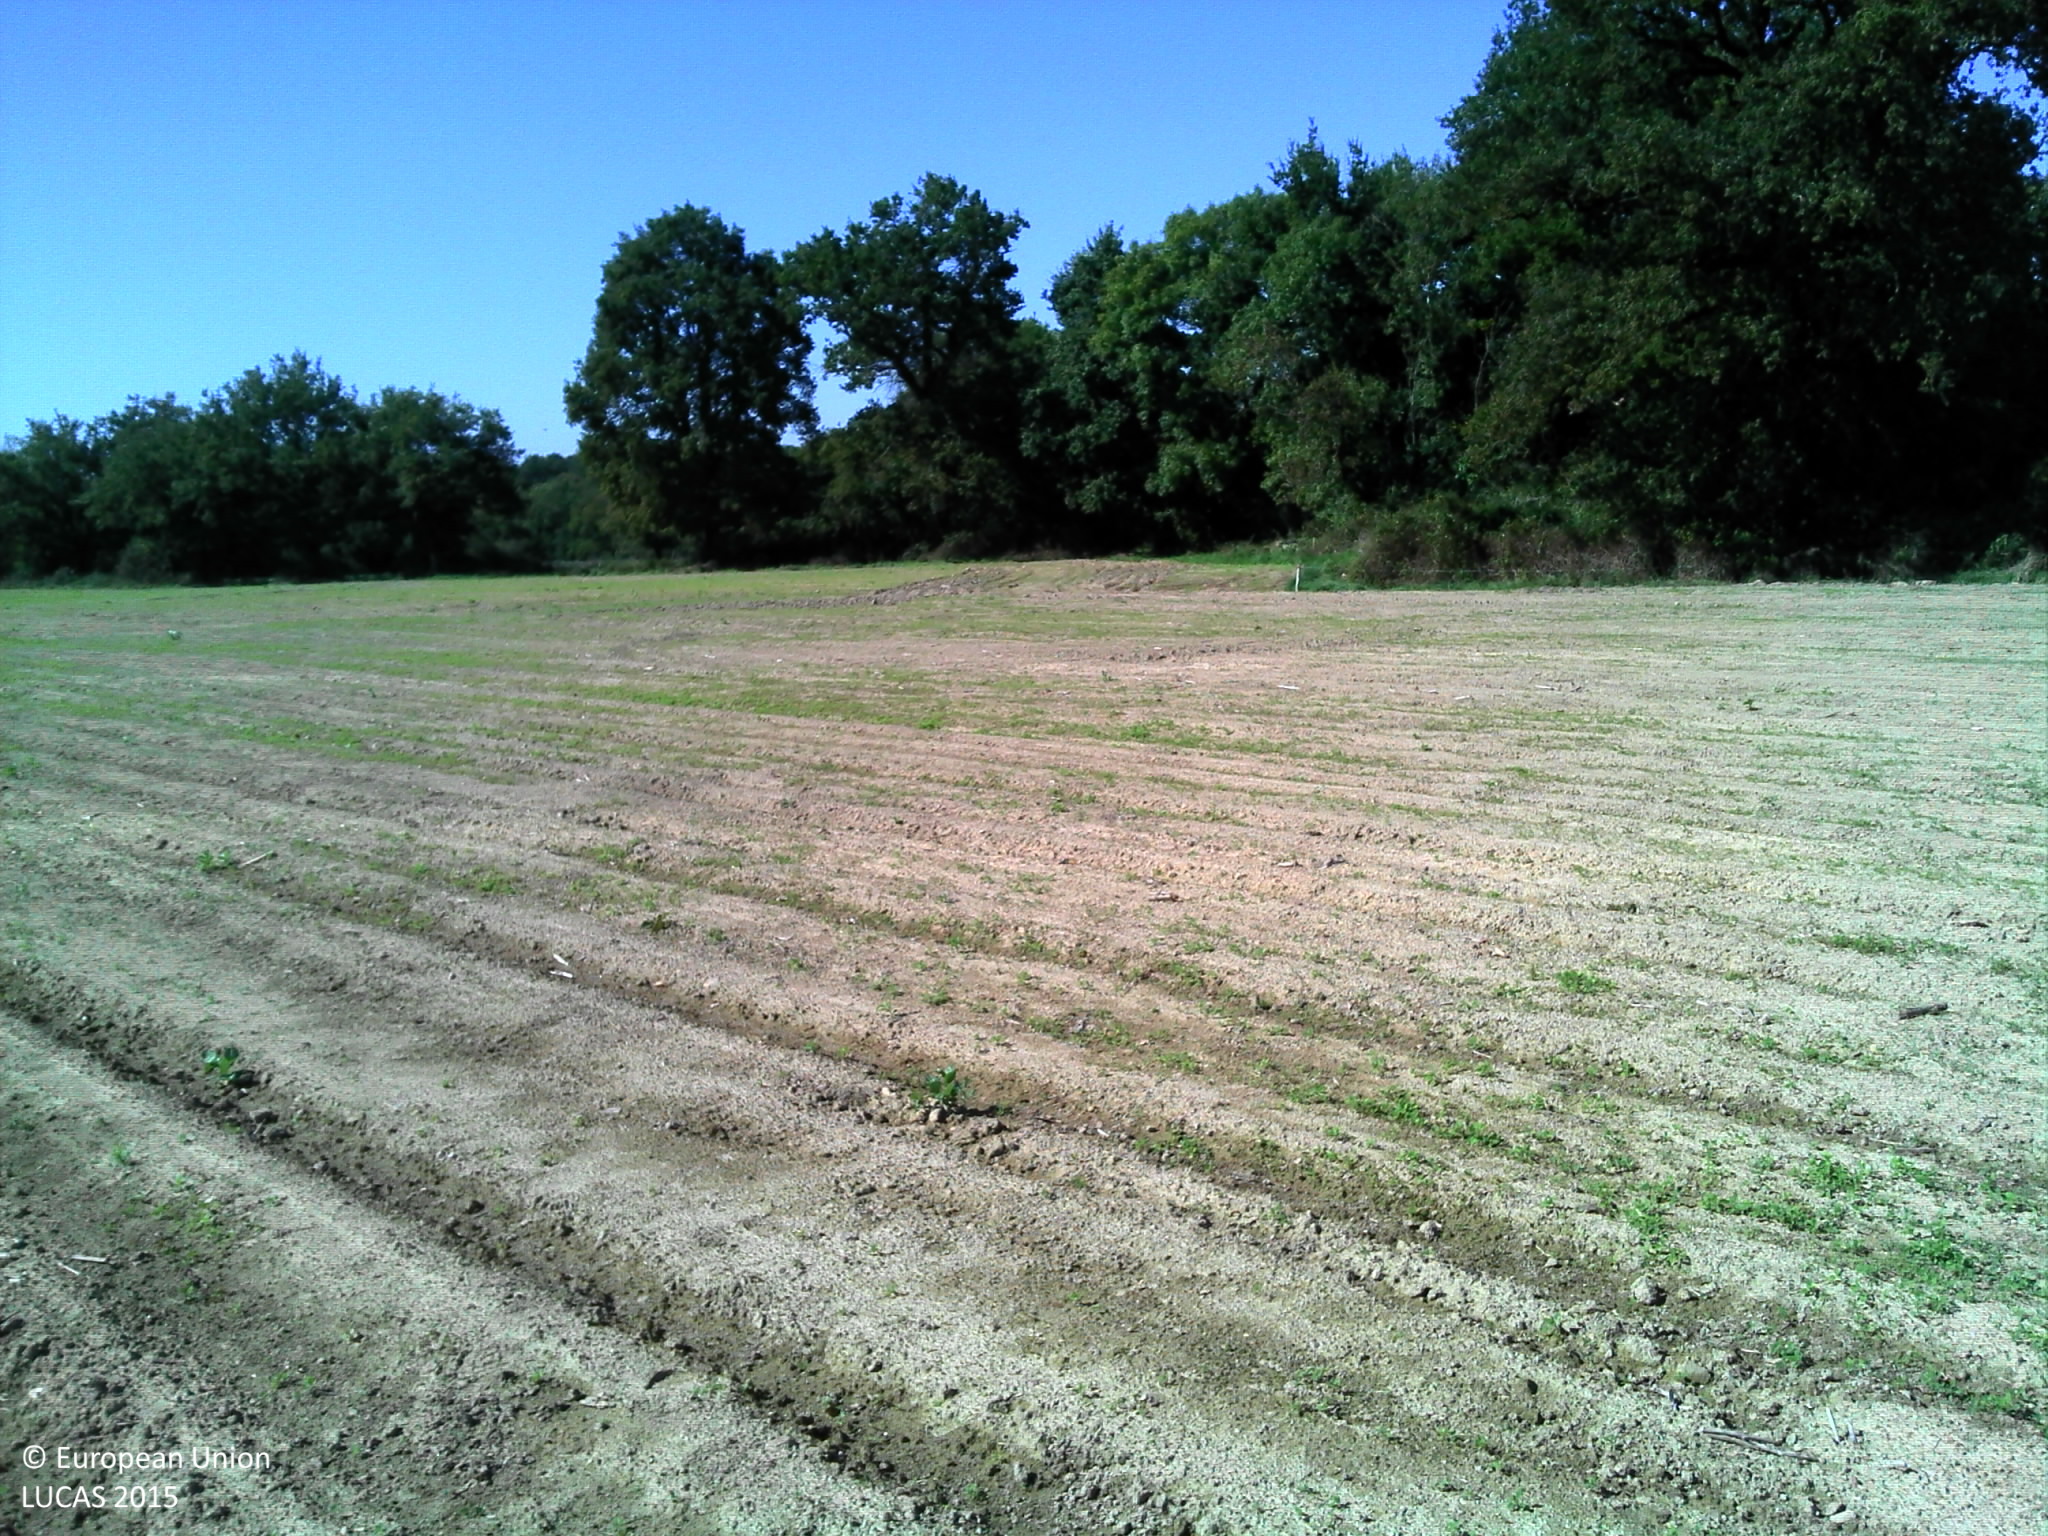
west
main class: Cropland
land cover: Dry pulses
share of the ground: > 75 %
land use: Agriculture (excluding fallow land and kitchen gardens)
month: September
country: FR
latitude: 46.5990
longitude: -1.3543
